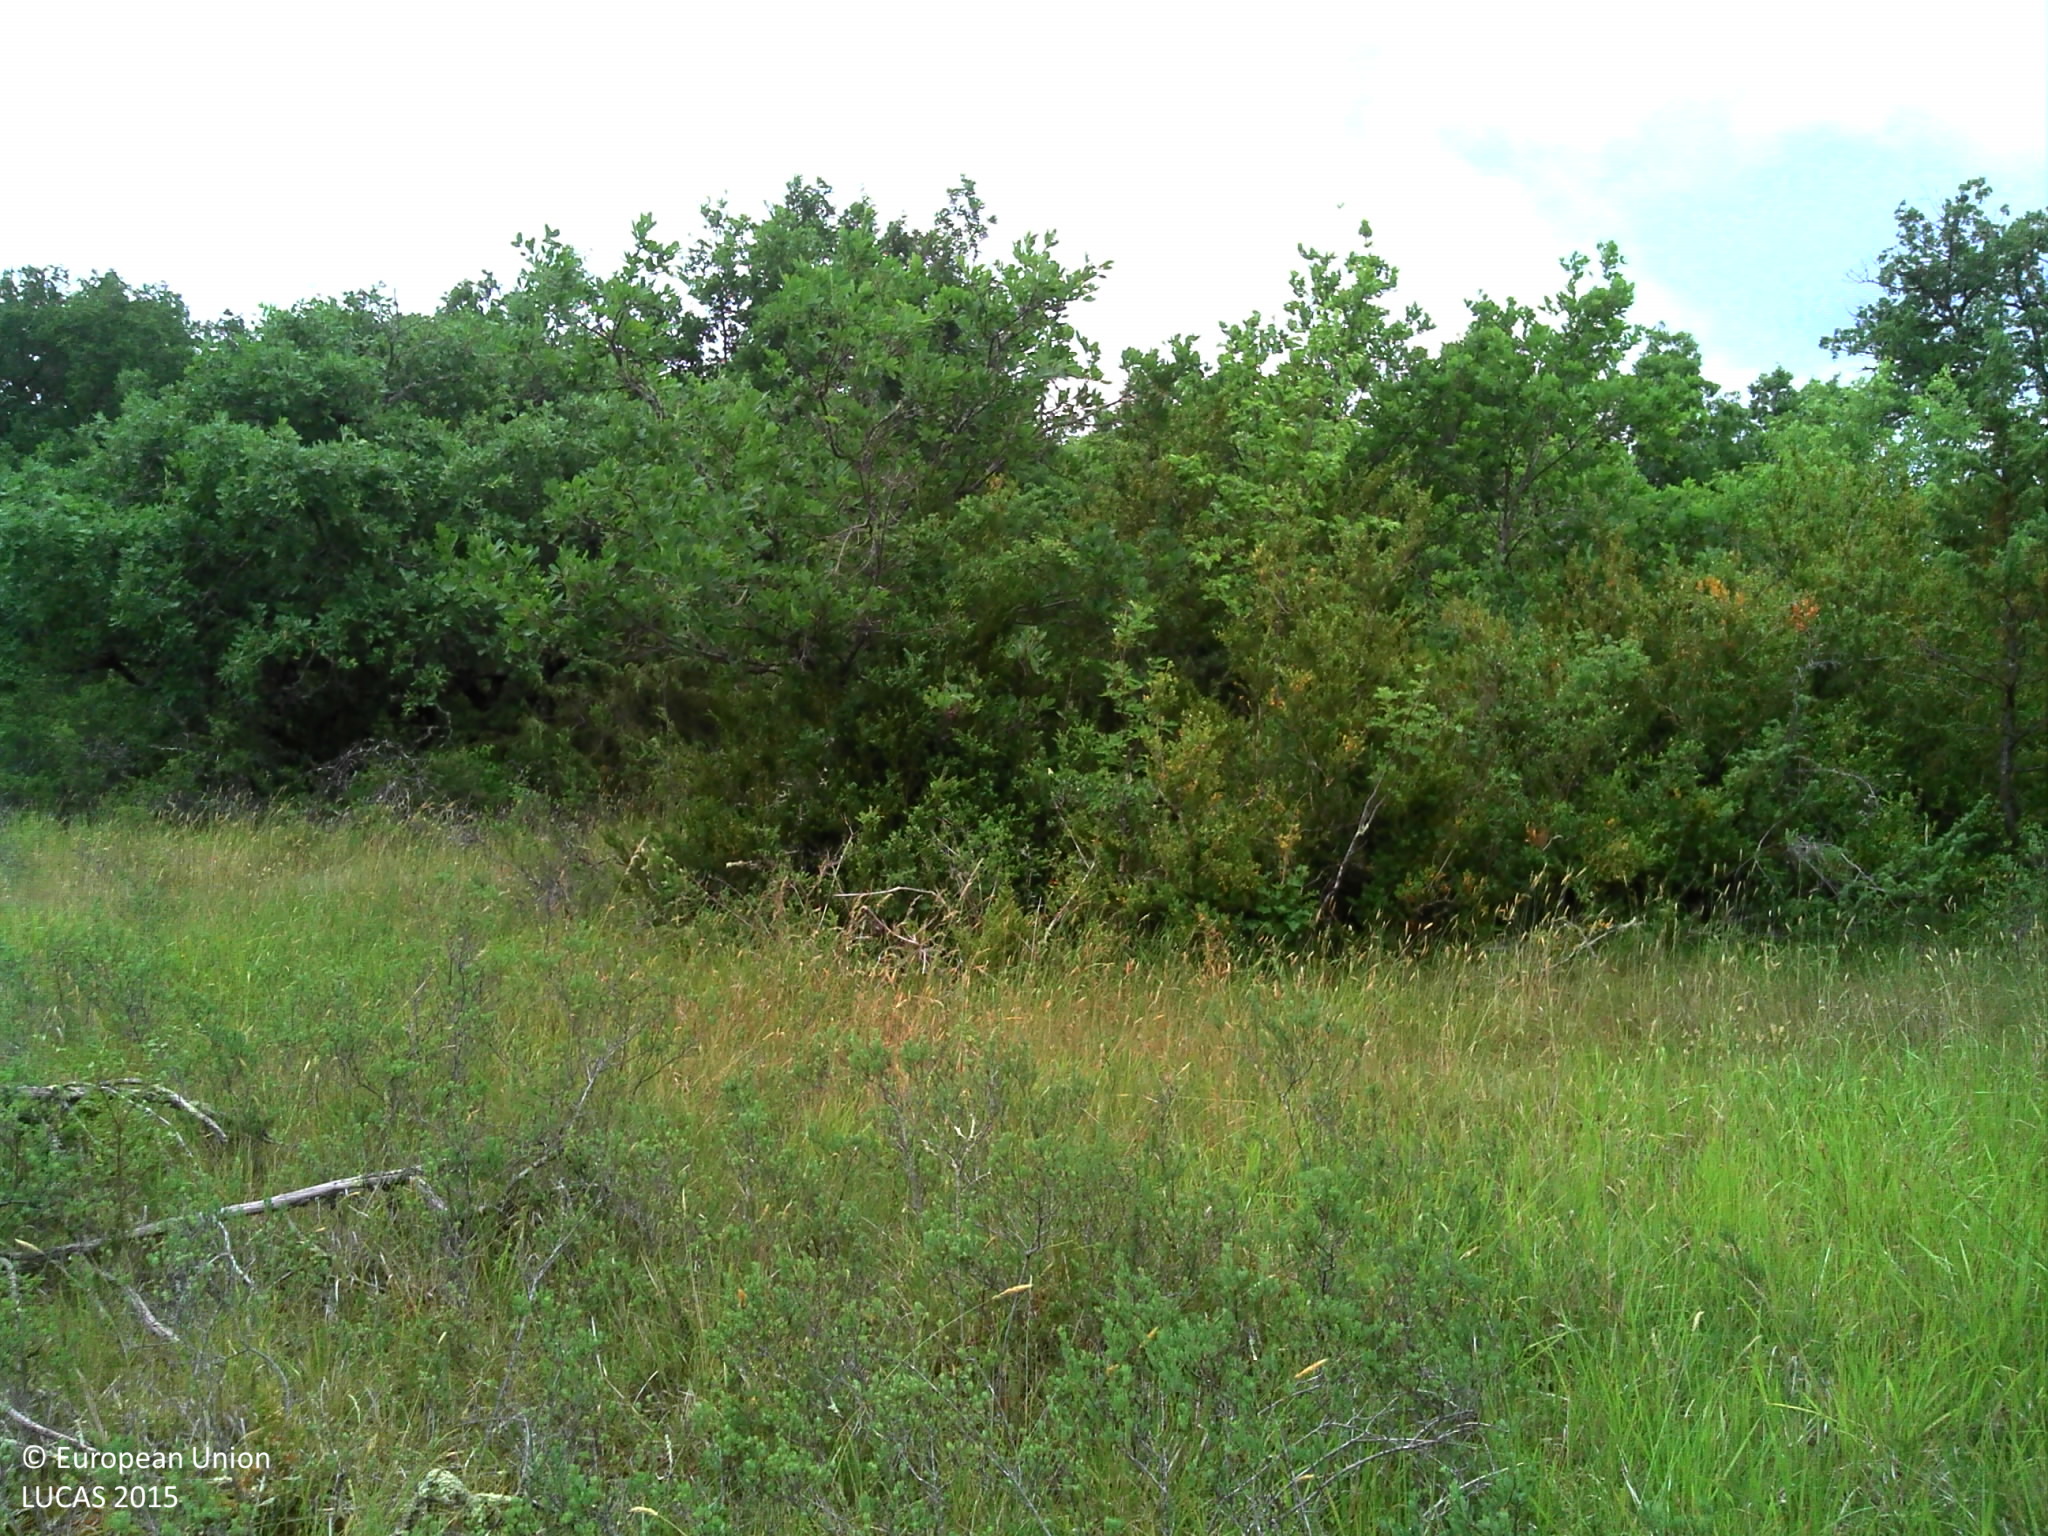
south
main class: Shrubland
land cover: Shrubland with sparse tree cover
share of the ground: > 75 %
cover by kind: shrubs 55 %, herbaceous plants 25 %, lichens and mosses 15 %, broadleaved forest trees 5 %
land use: Agriculture (excluding fallow land and kitchen gardens)
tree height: > 5 m
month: June
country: FR
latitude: 44.4678
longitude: 1.8926
